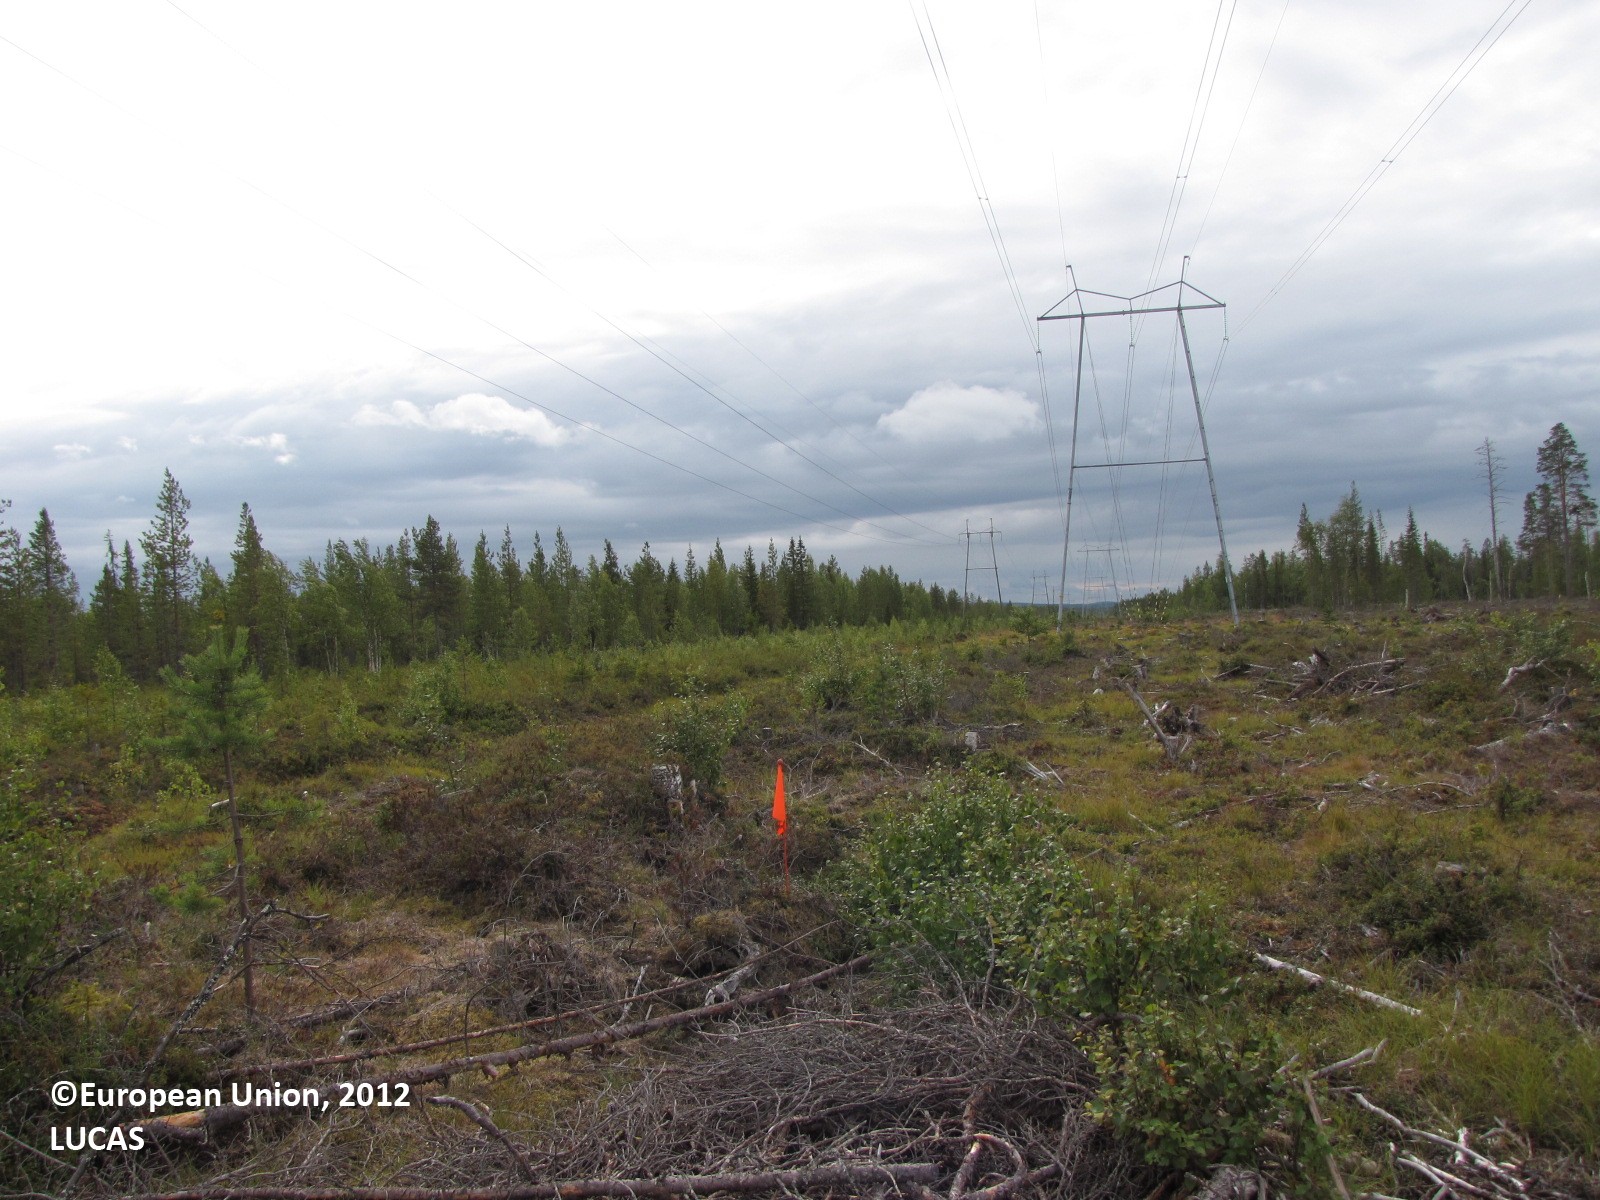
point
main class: Shrubland
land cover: Shrubland with sparse tree cover
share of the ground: > 75 %
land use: Energy production
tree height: < 5 m
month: August
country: FI
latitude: 67.1107
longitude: 25.0917
